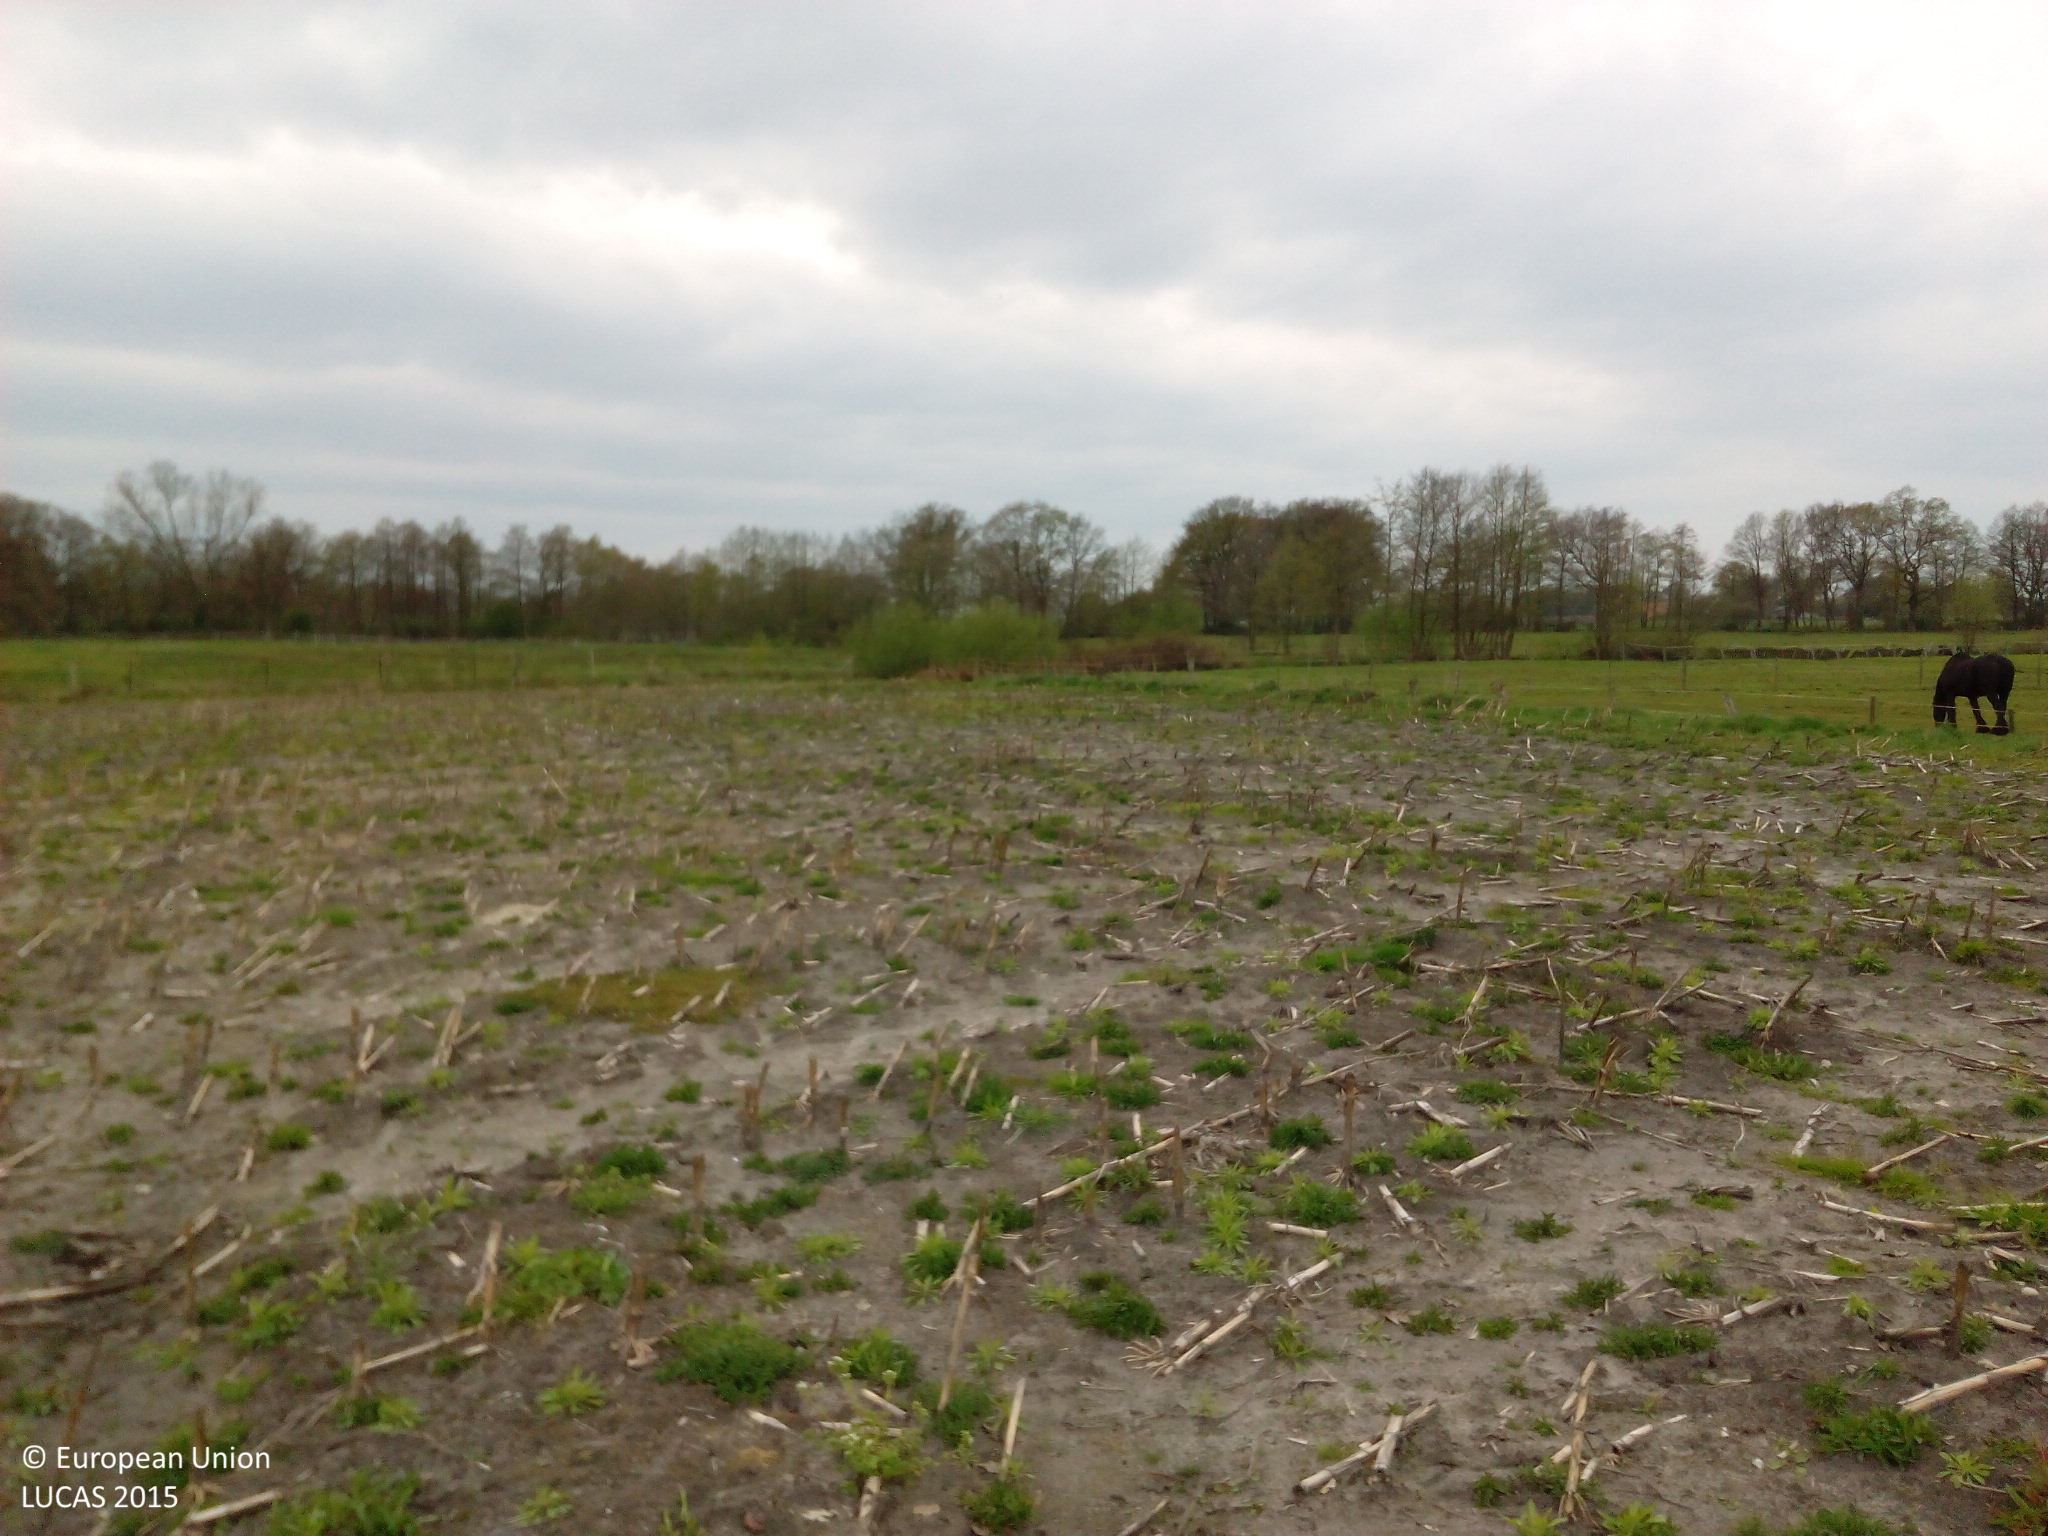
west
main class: Grassland
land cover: Spontaneously vegetated surfaces
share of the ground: 50 - 75 %
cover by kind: herbaceous plants 50 %, consolidated bare surface 30 %, lichens and mosses 20 %
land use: Fallow land
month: May
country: DE
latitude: 53.2498
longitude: 8.5768
